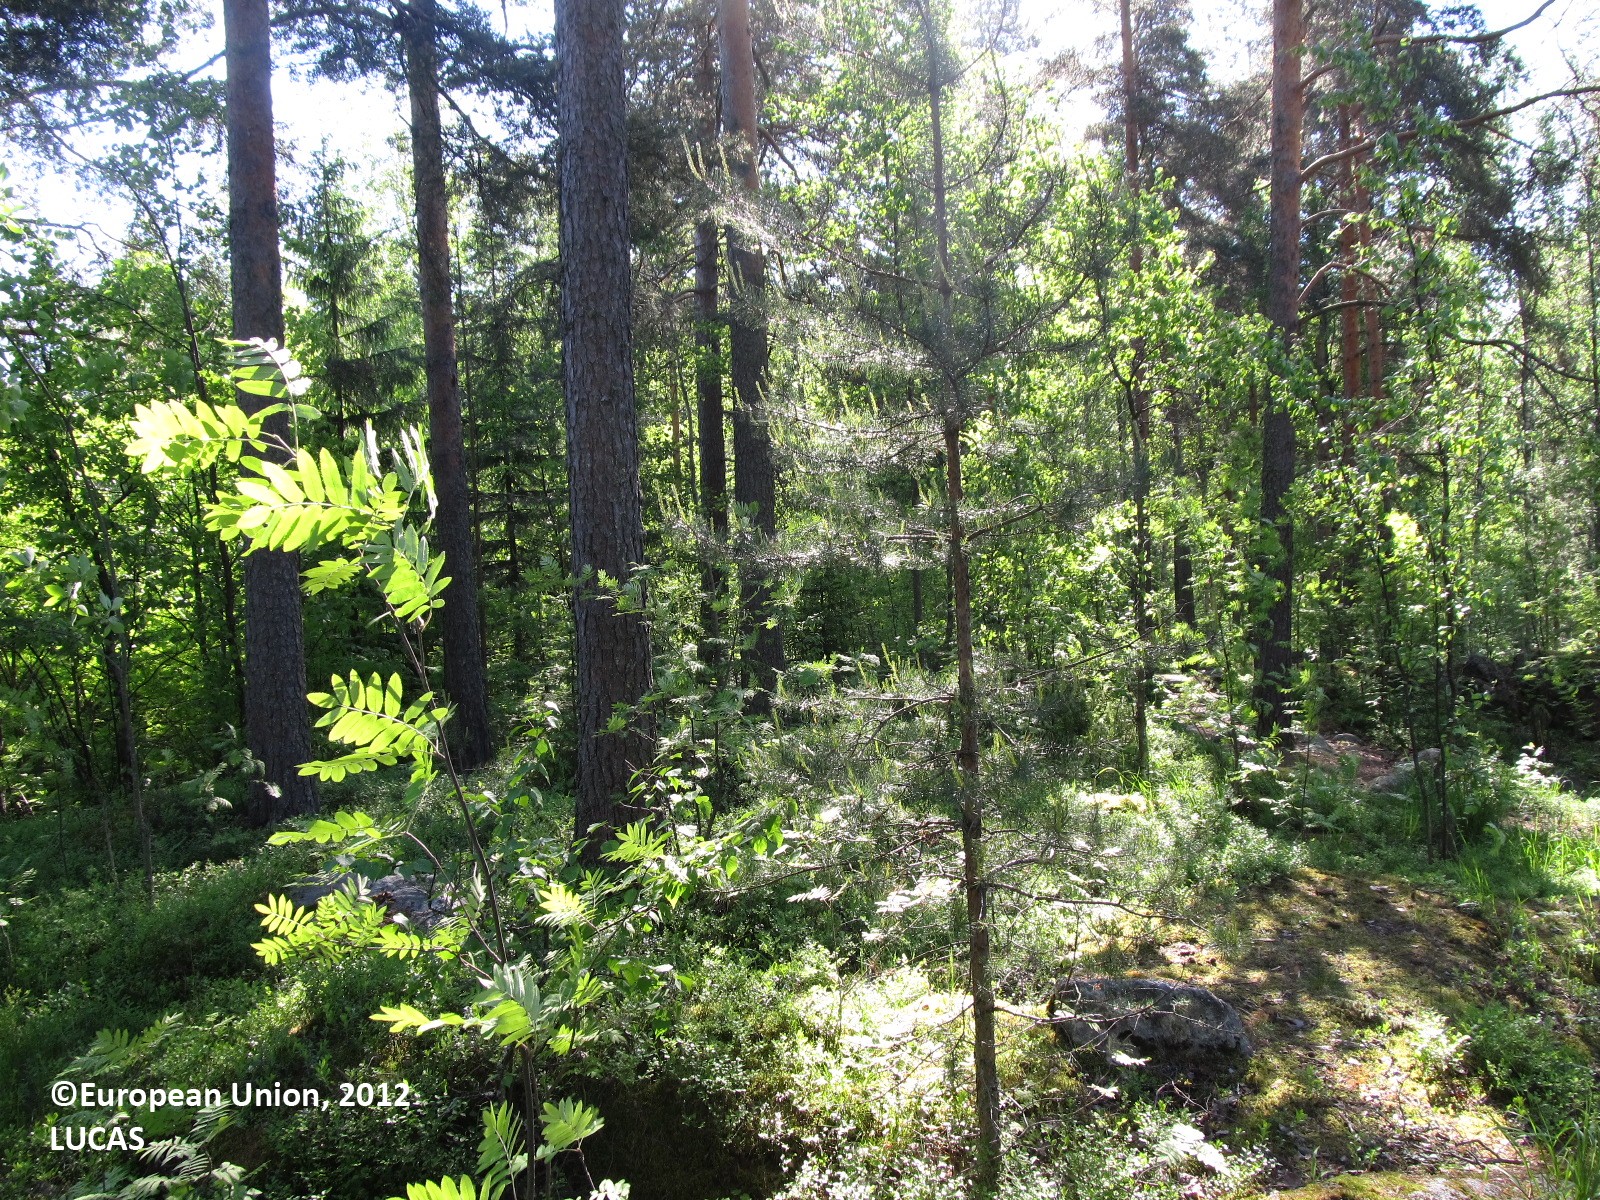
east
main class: Woodland
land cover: Pine dominated coniferous woodland
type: boreal forest
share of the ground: 25 - 50 %
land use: Sport
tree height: > 5 m
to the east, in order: Pine dominated coniferous woodland; Pine dominated mixed woodland; Electric lines; Tracks; Broadleaved woodland; Pine dominated coniferous woodland; Tracks; Broadleaved woodland; Inland water bodies
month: June
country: FI
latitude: 62.8755
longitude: 27.6455
